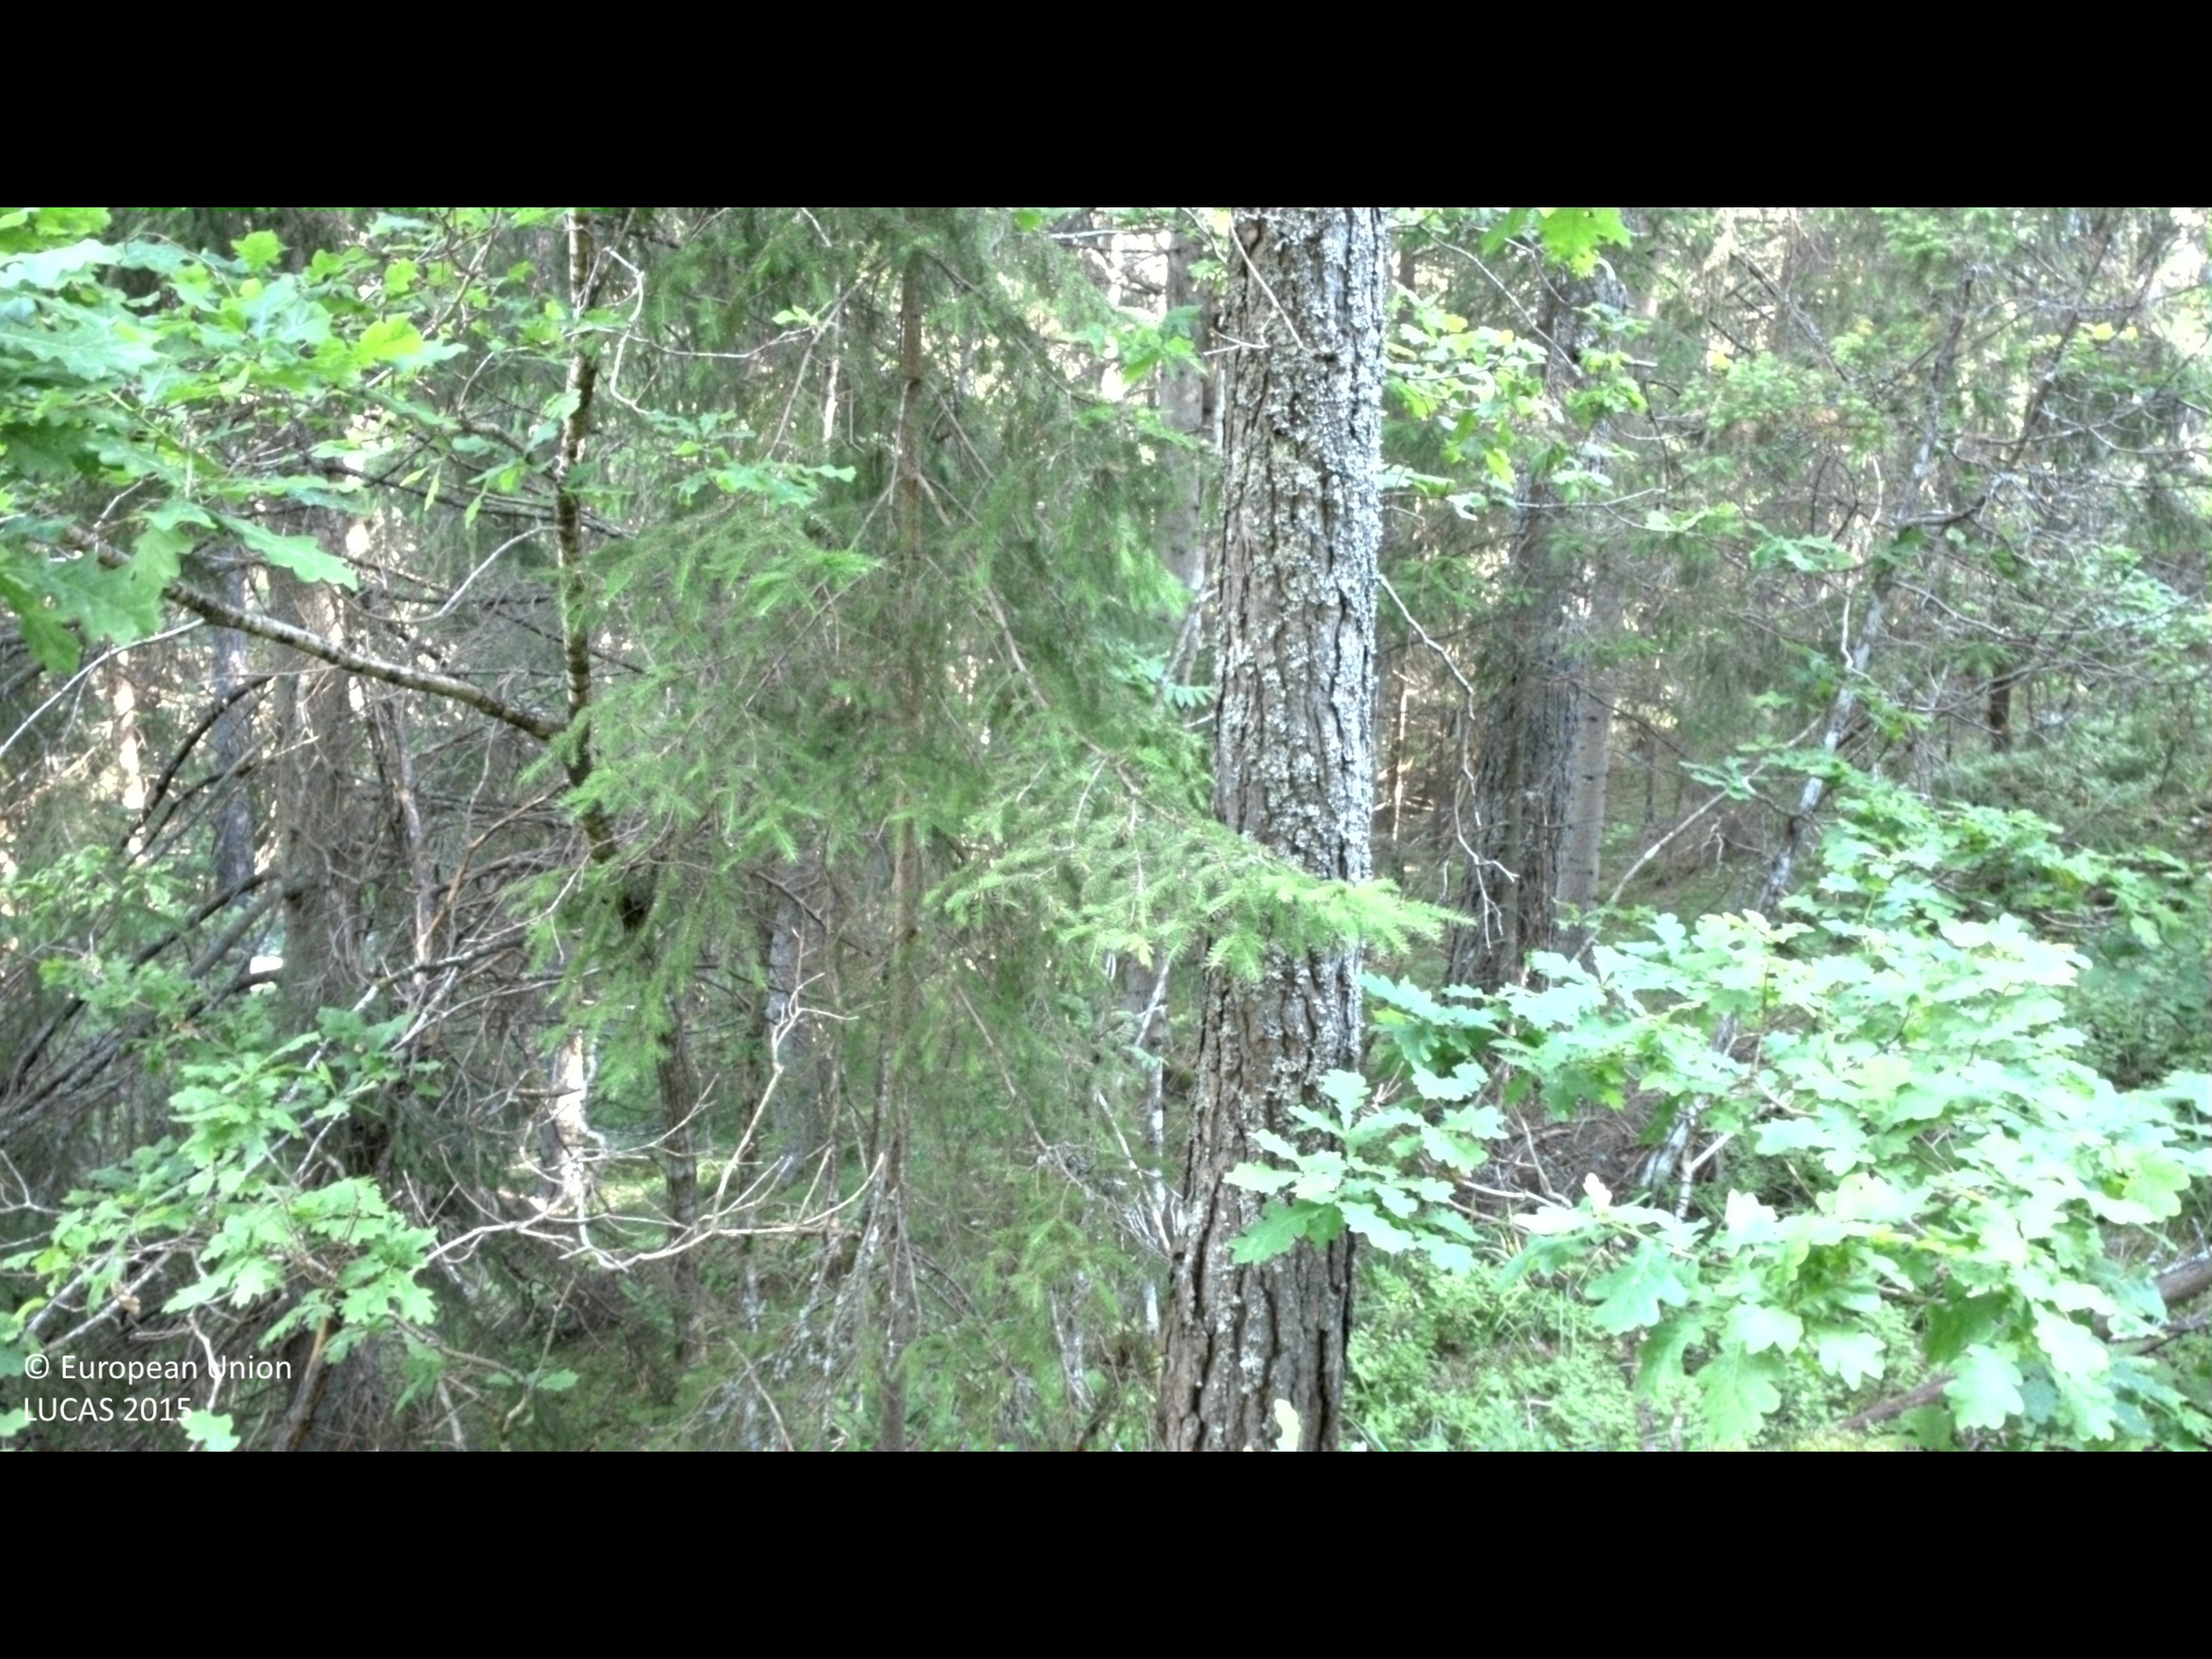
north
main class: Woodland
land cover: Spruce dominated coniferous woodland
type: boreal forest
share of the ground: 50 - 75 %
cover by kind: coniferous forest trees 65 %, shrubs 25 %, broadleaved forest trees 10 %
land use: Forestry
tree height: > 5 m
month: June
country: SE
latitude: 58.1702
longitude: 16.5082
